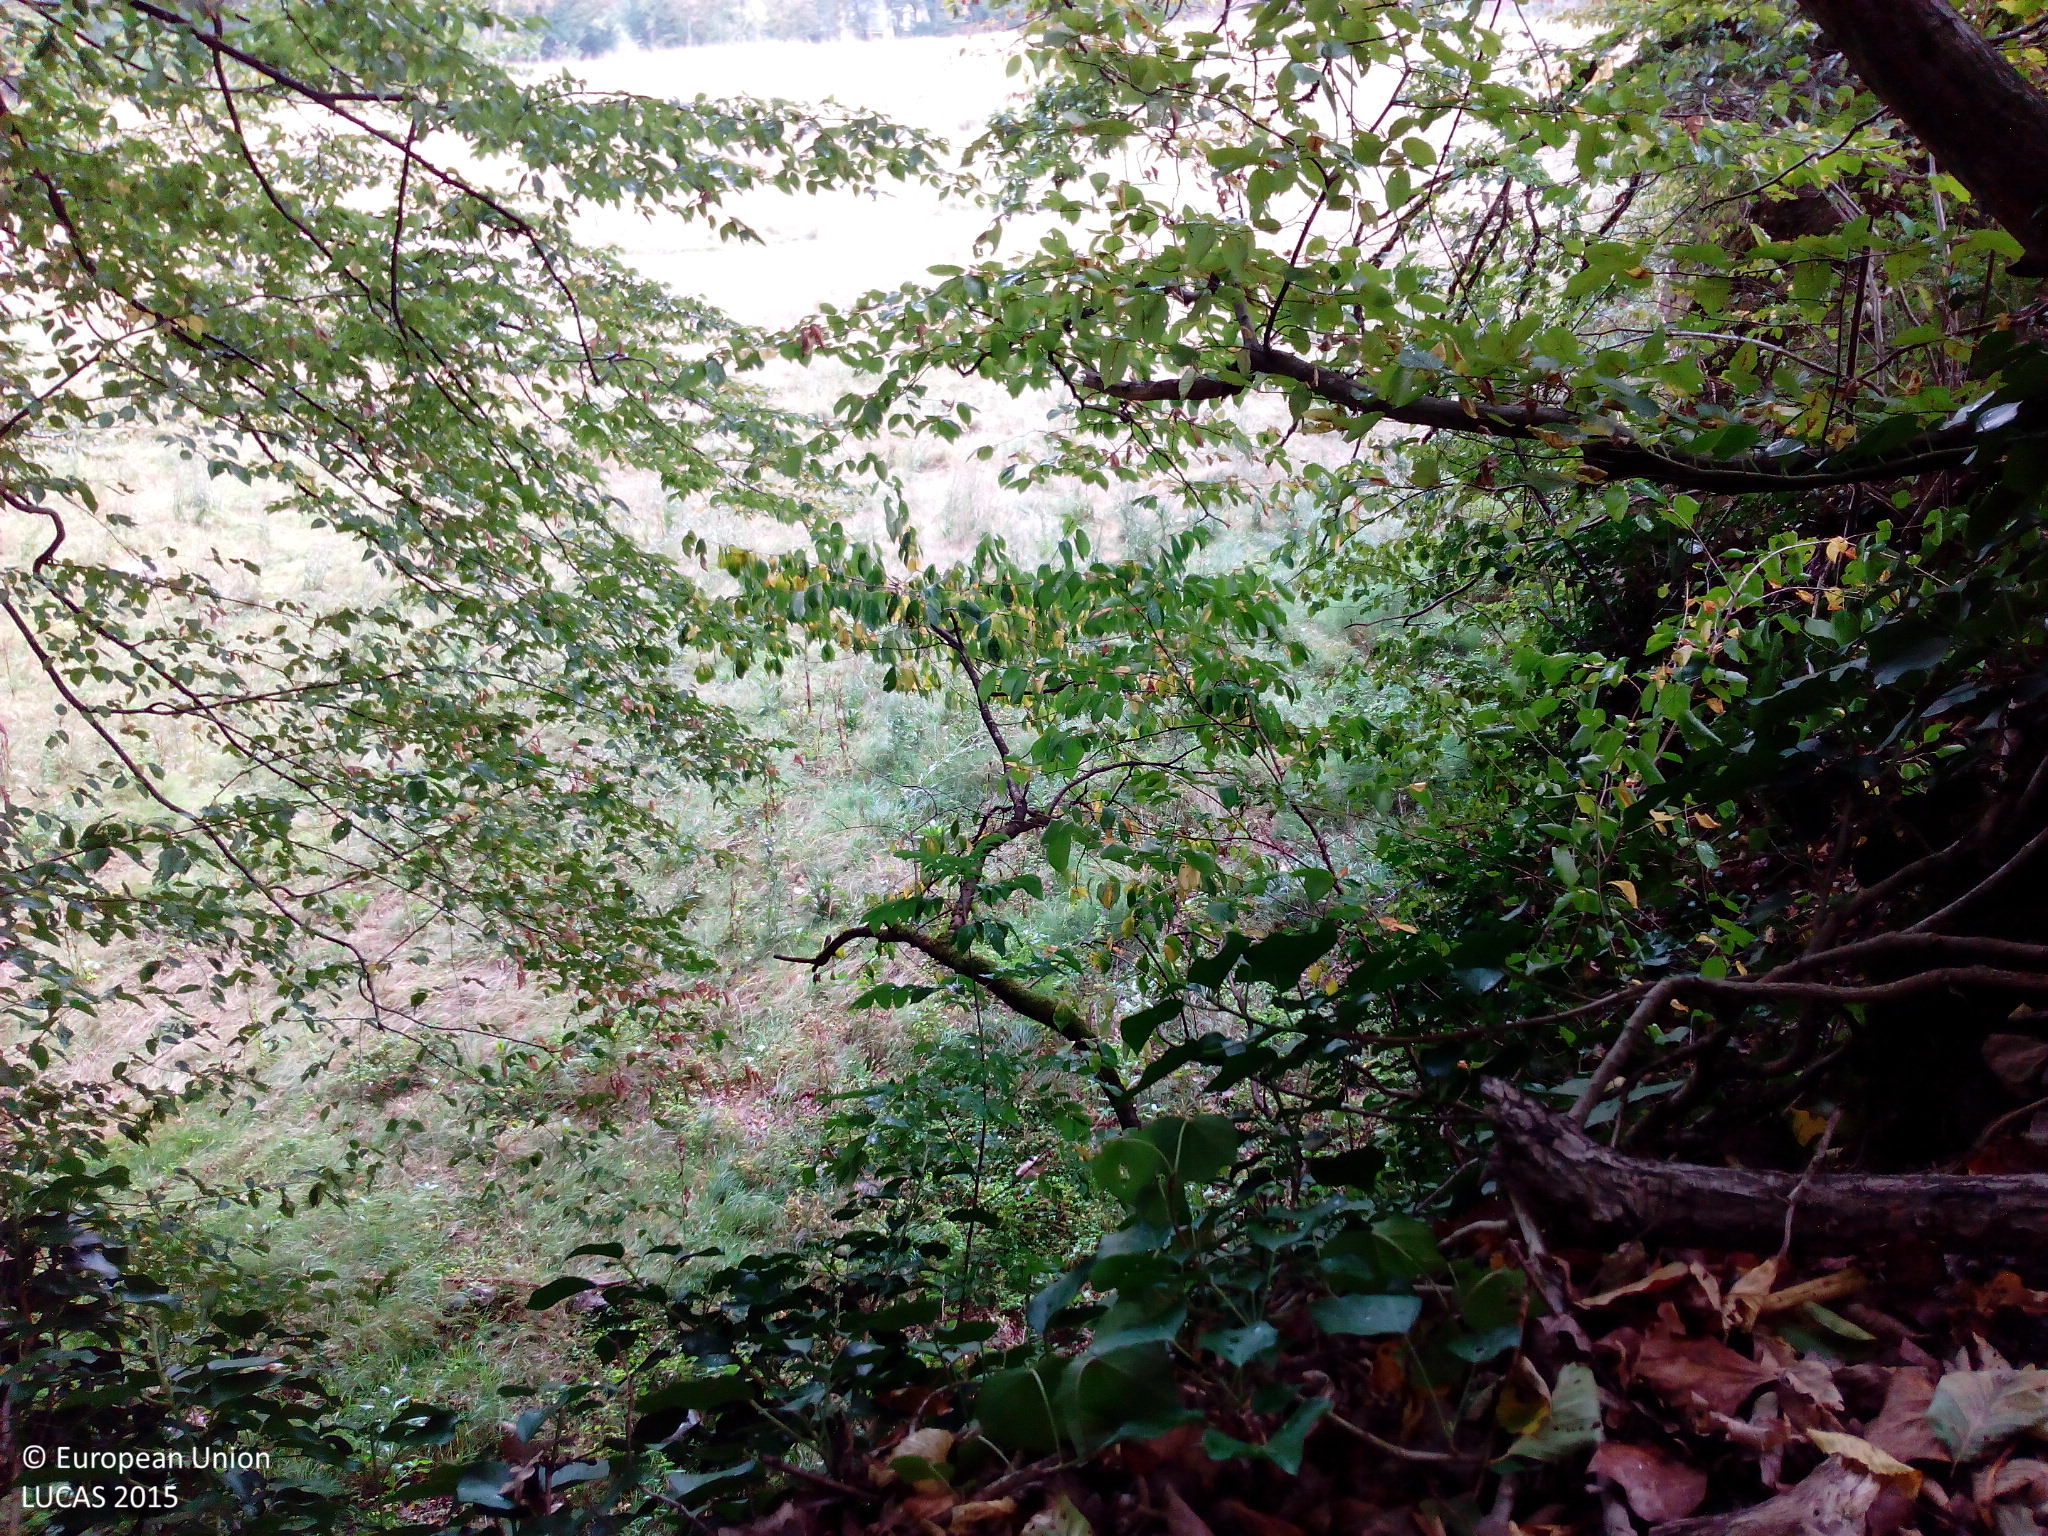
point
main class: Woodland
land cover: Broadleaved woodland
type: beech forest
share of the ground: > 75 %
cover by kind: broadleaved forest trees 80 %, herbaceous plants 20 %
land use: Abandoned areas
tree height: > 5 m
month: August
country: DE
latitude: 47.5956
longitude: 8.1262
